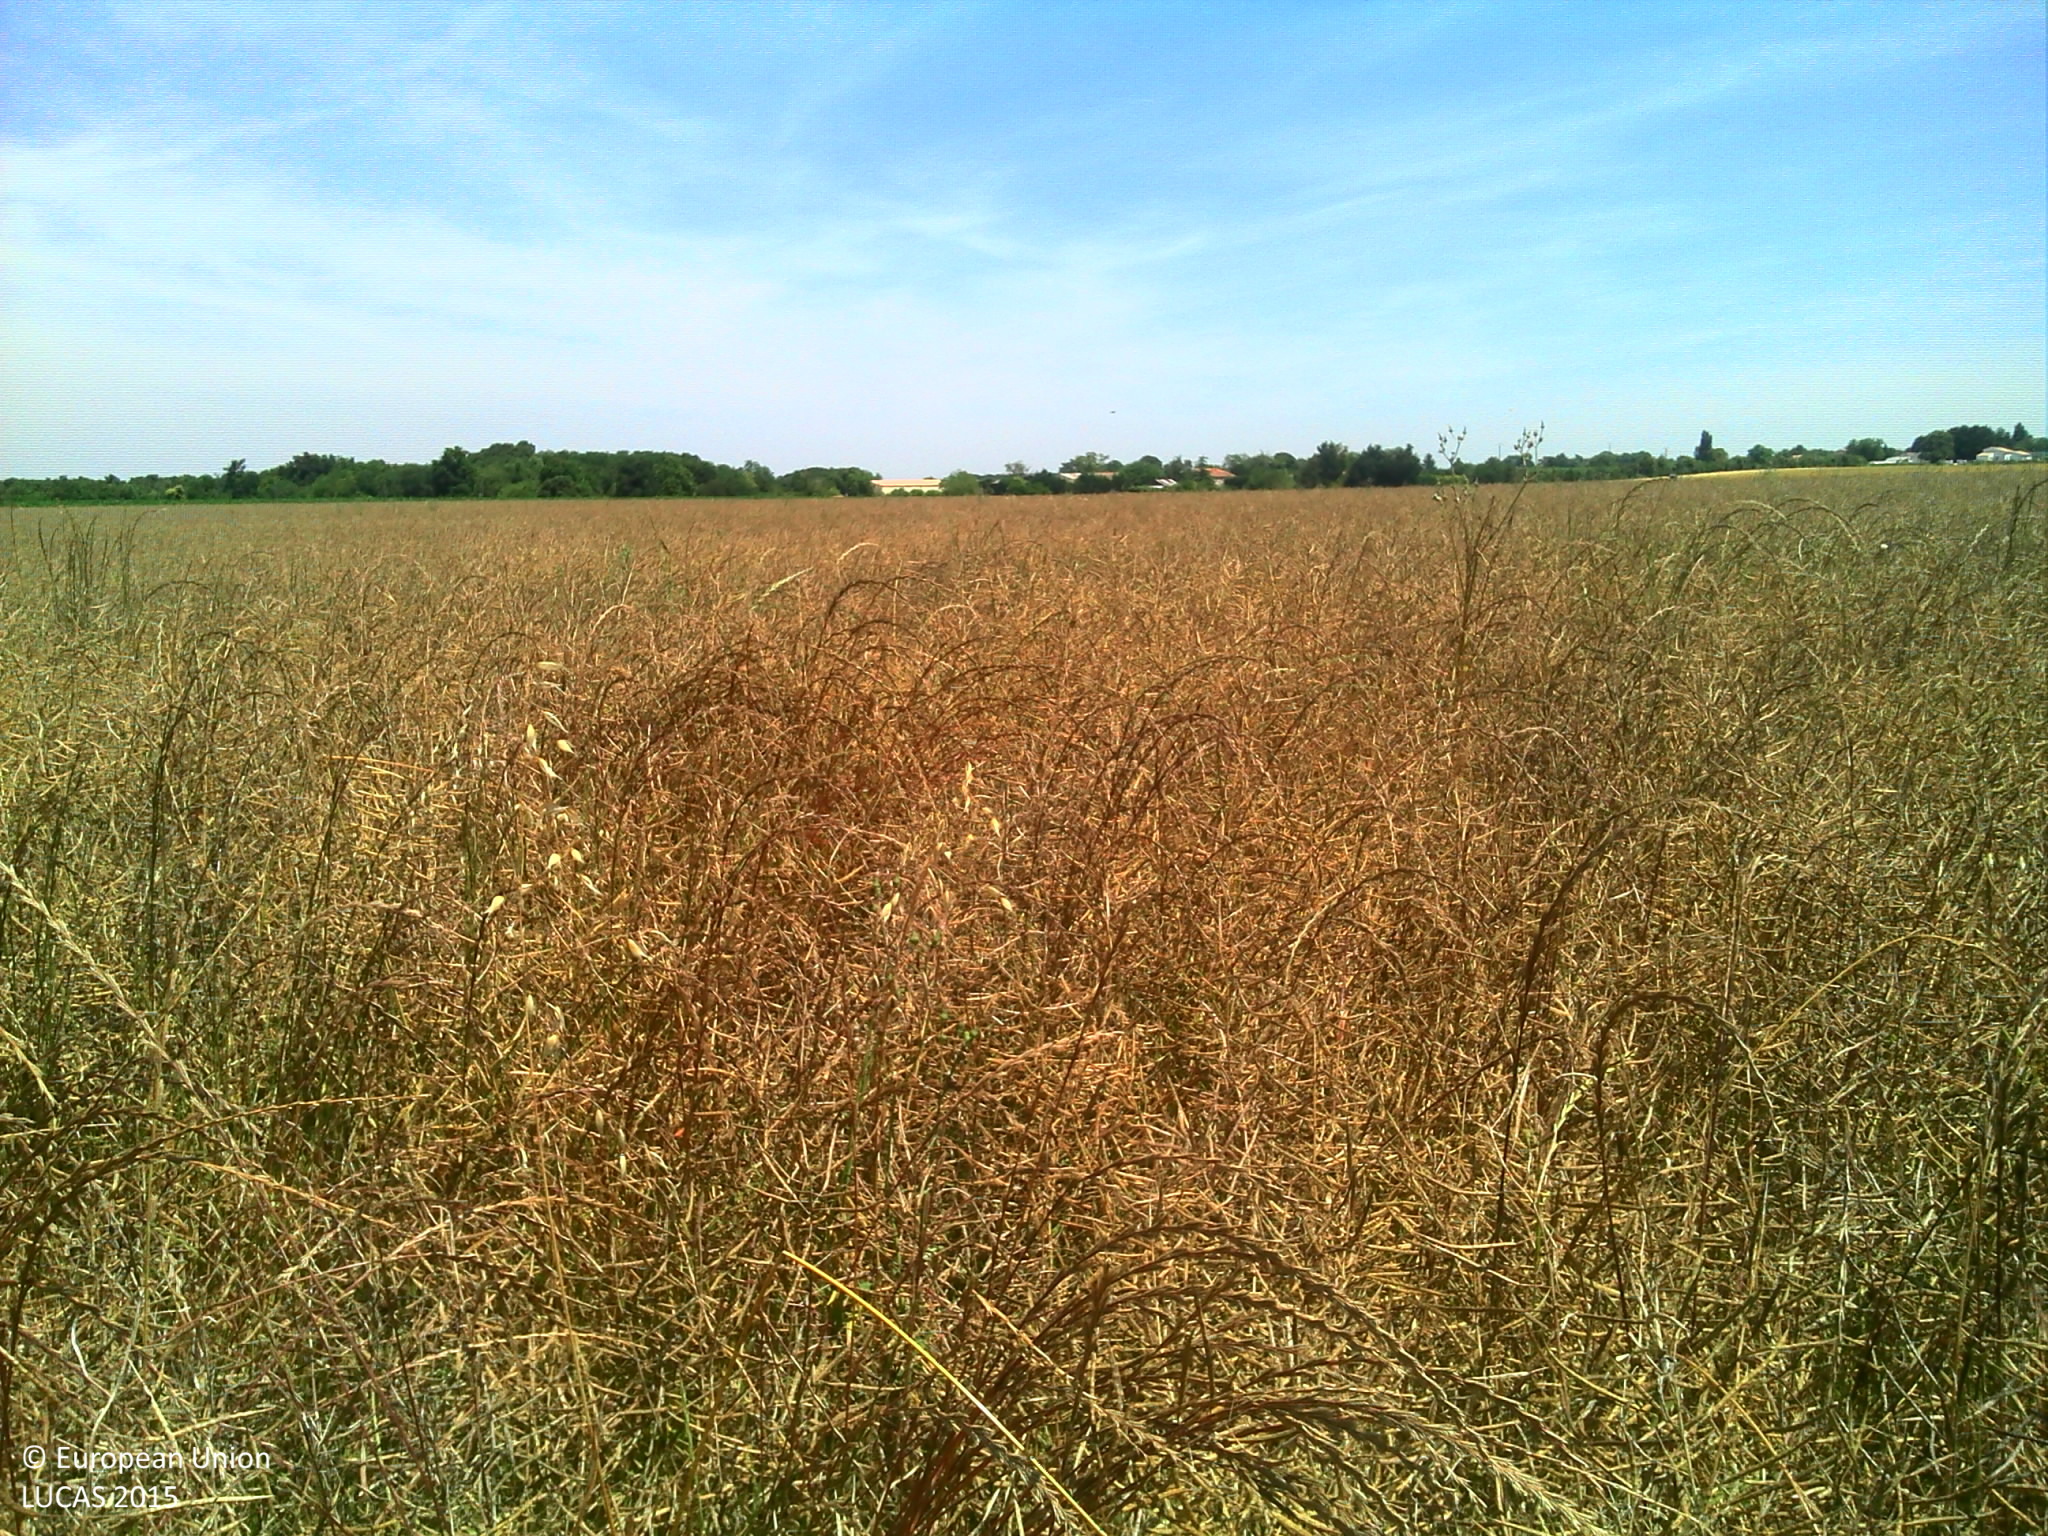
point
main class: Cropland
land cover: Rape and turnip rape
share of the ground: > 75 %
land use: Agriculture (excluding fallow land and kitchen gardens)
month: June
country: FR
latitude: 45.7215
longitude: -0.8833
